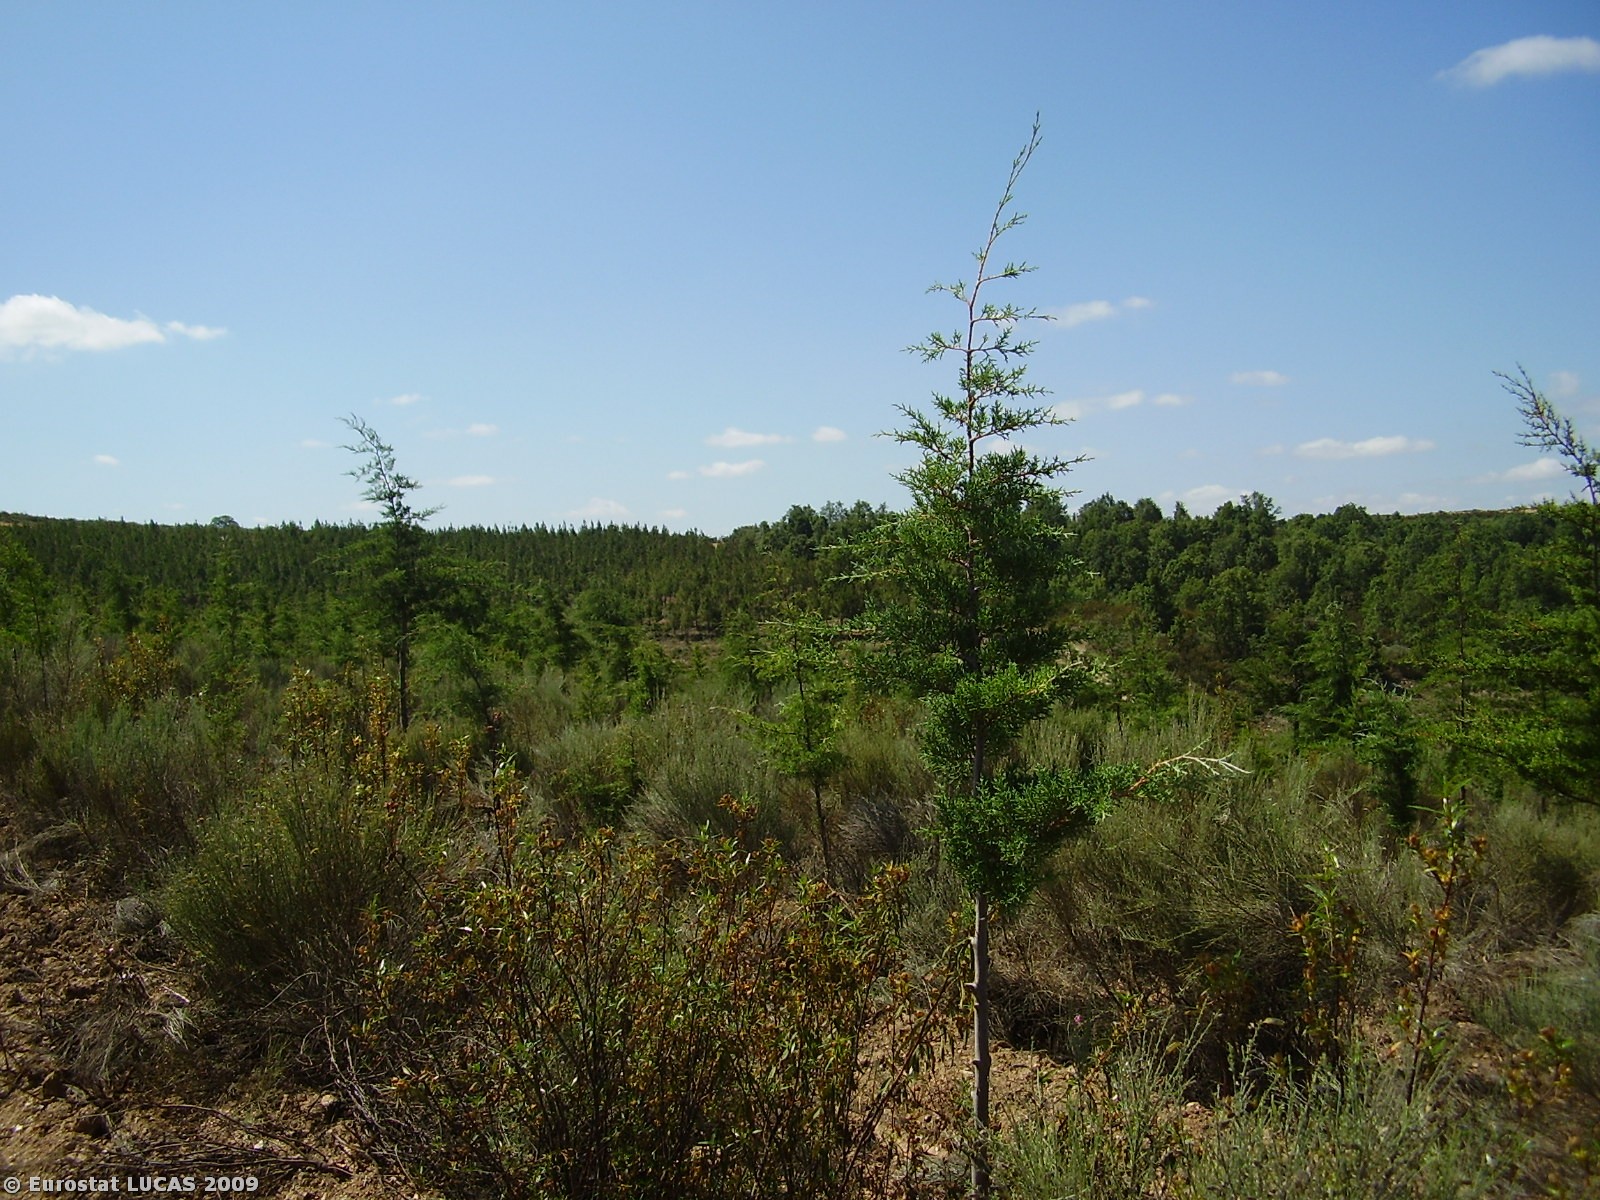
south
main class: Woodland
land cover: Coniferous woodland
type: coniferous forest of the mediterranean region
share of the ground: 10 - 25 %
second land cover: Spontaneously vegetated surfaces
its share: 10 - 25 %
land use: Forestry
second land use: Unused
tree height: > 5 m
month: June
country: PT
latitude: 41.6153
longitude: -6.5342
